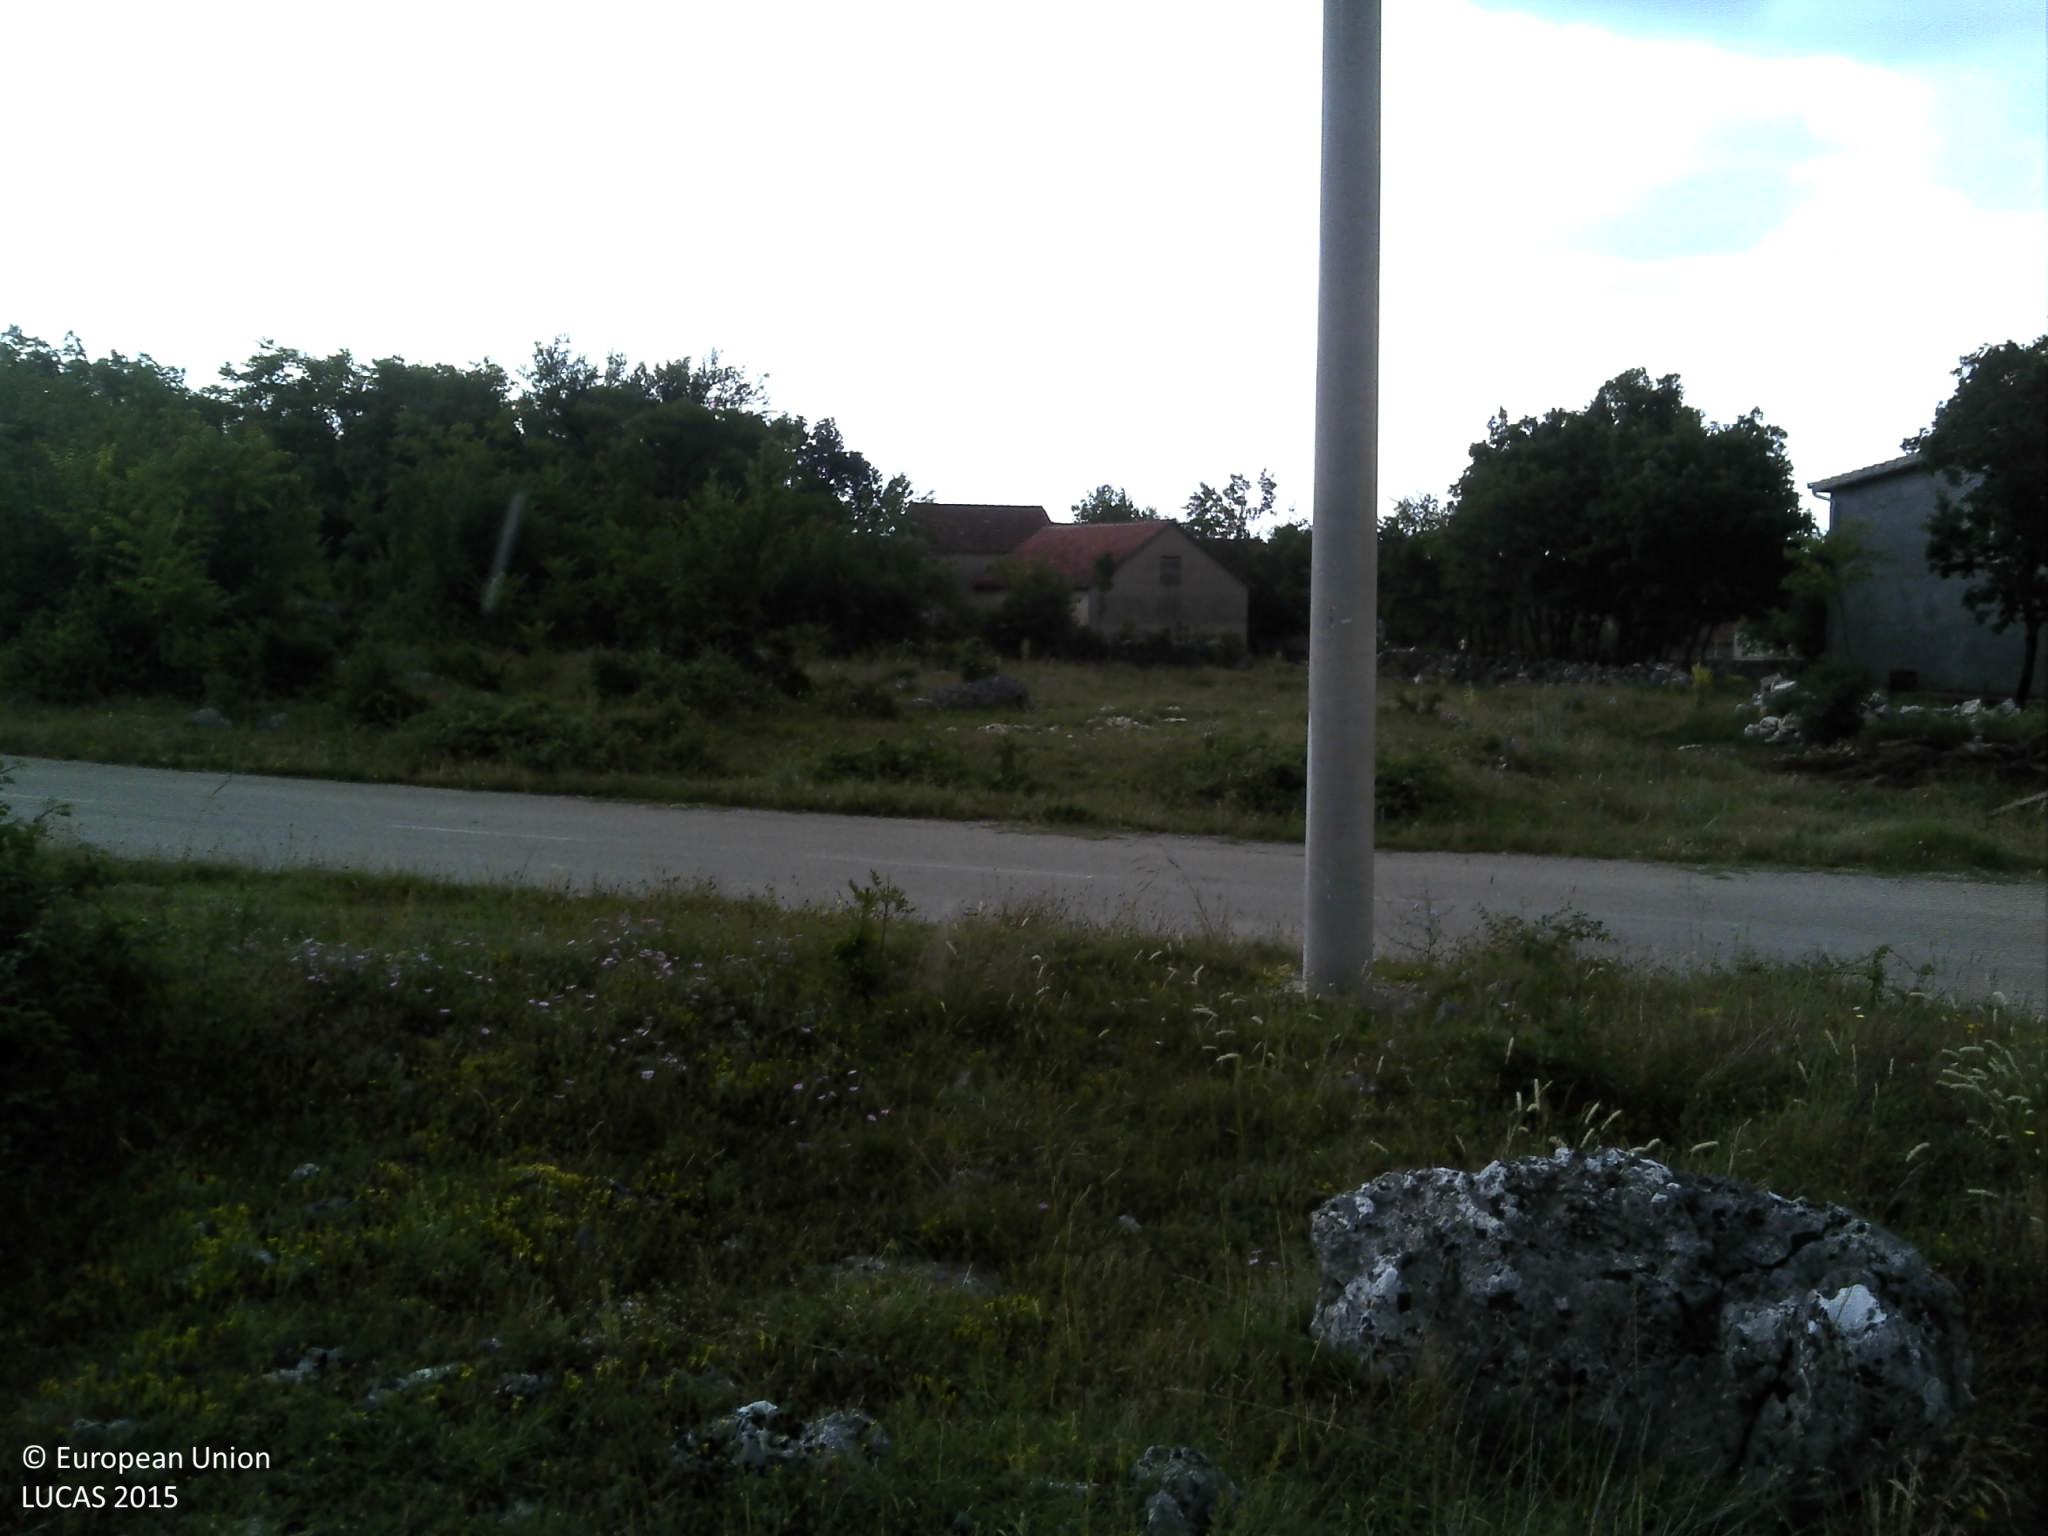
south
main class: Grassland
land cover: Grassland with sparse tree/shrub cover
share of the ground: 50 - 75 %
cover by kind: herbaceous plants 65 %, unconsolidated bare surface 20 %, broadleaved forest trees 5 %, shrubs 5 %, consolidated bare surface 5 %
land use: Abandoned areas
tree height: > 5 m
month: June
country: HR
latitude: 43.7955
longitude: 16.6165
